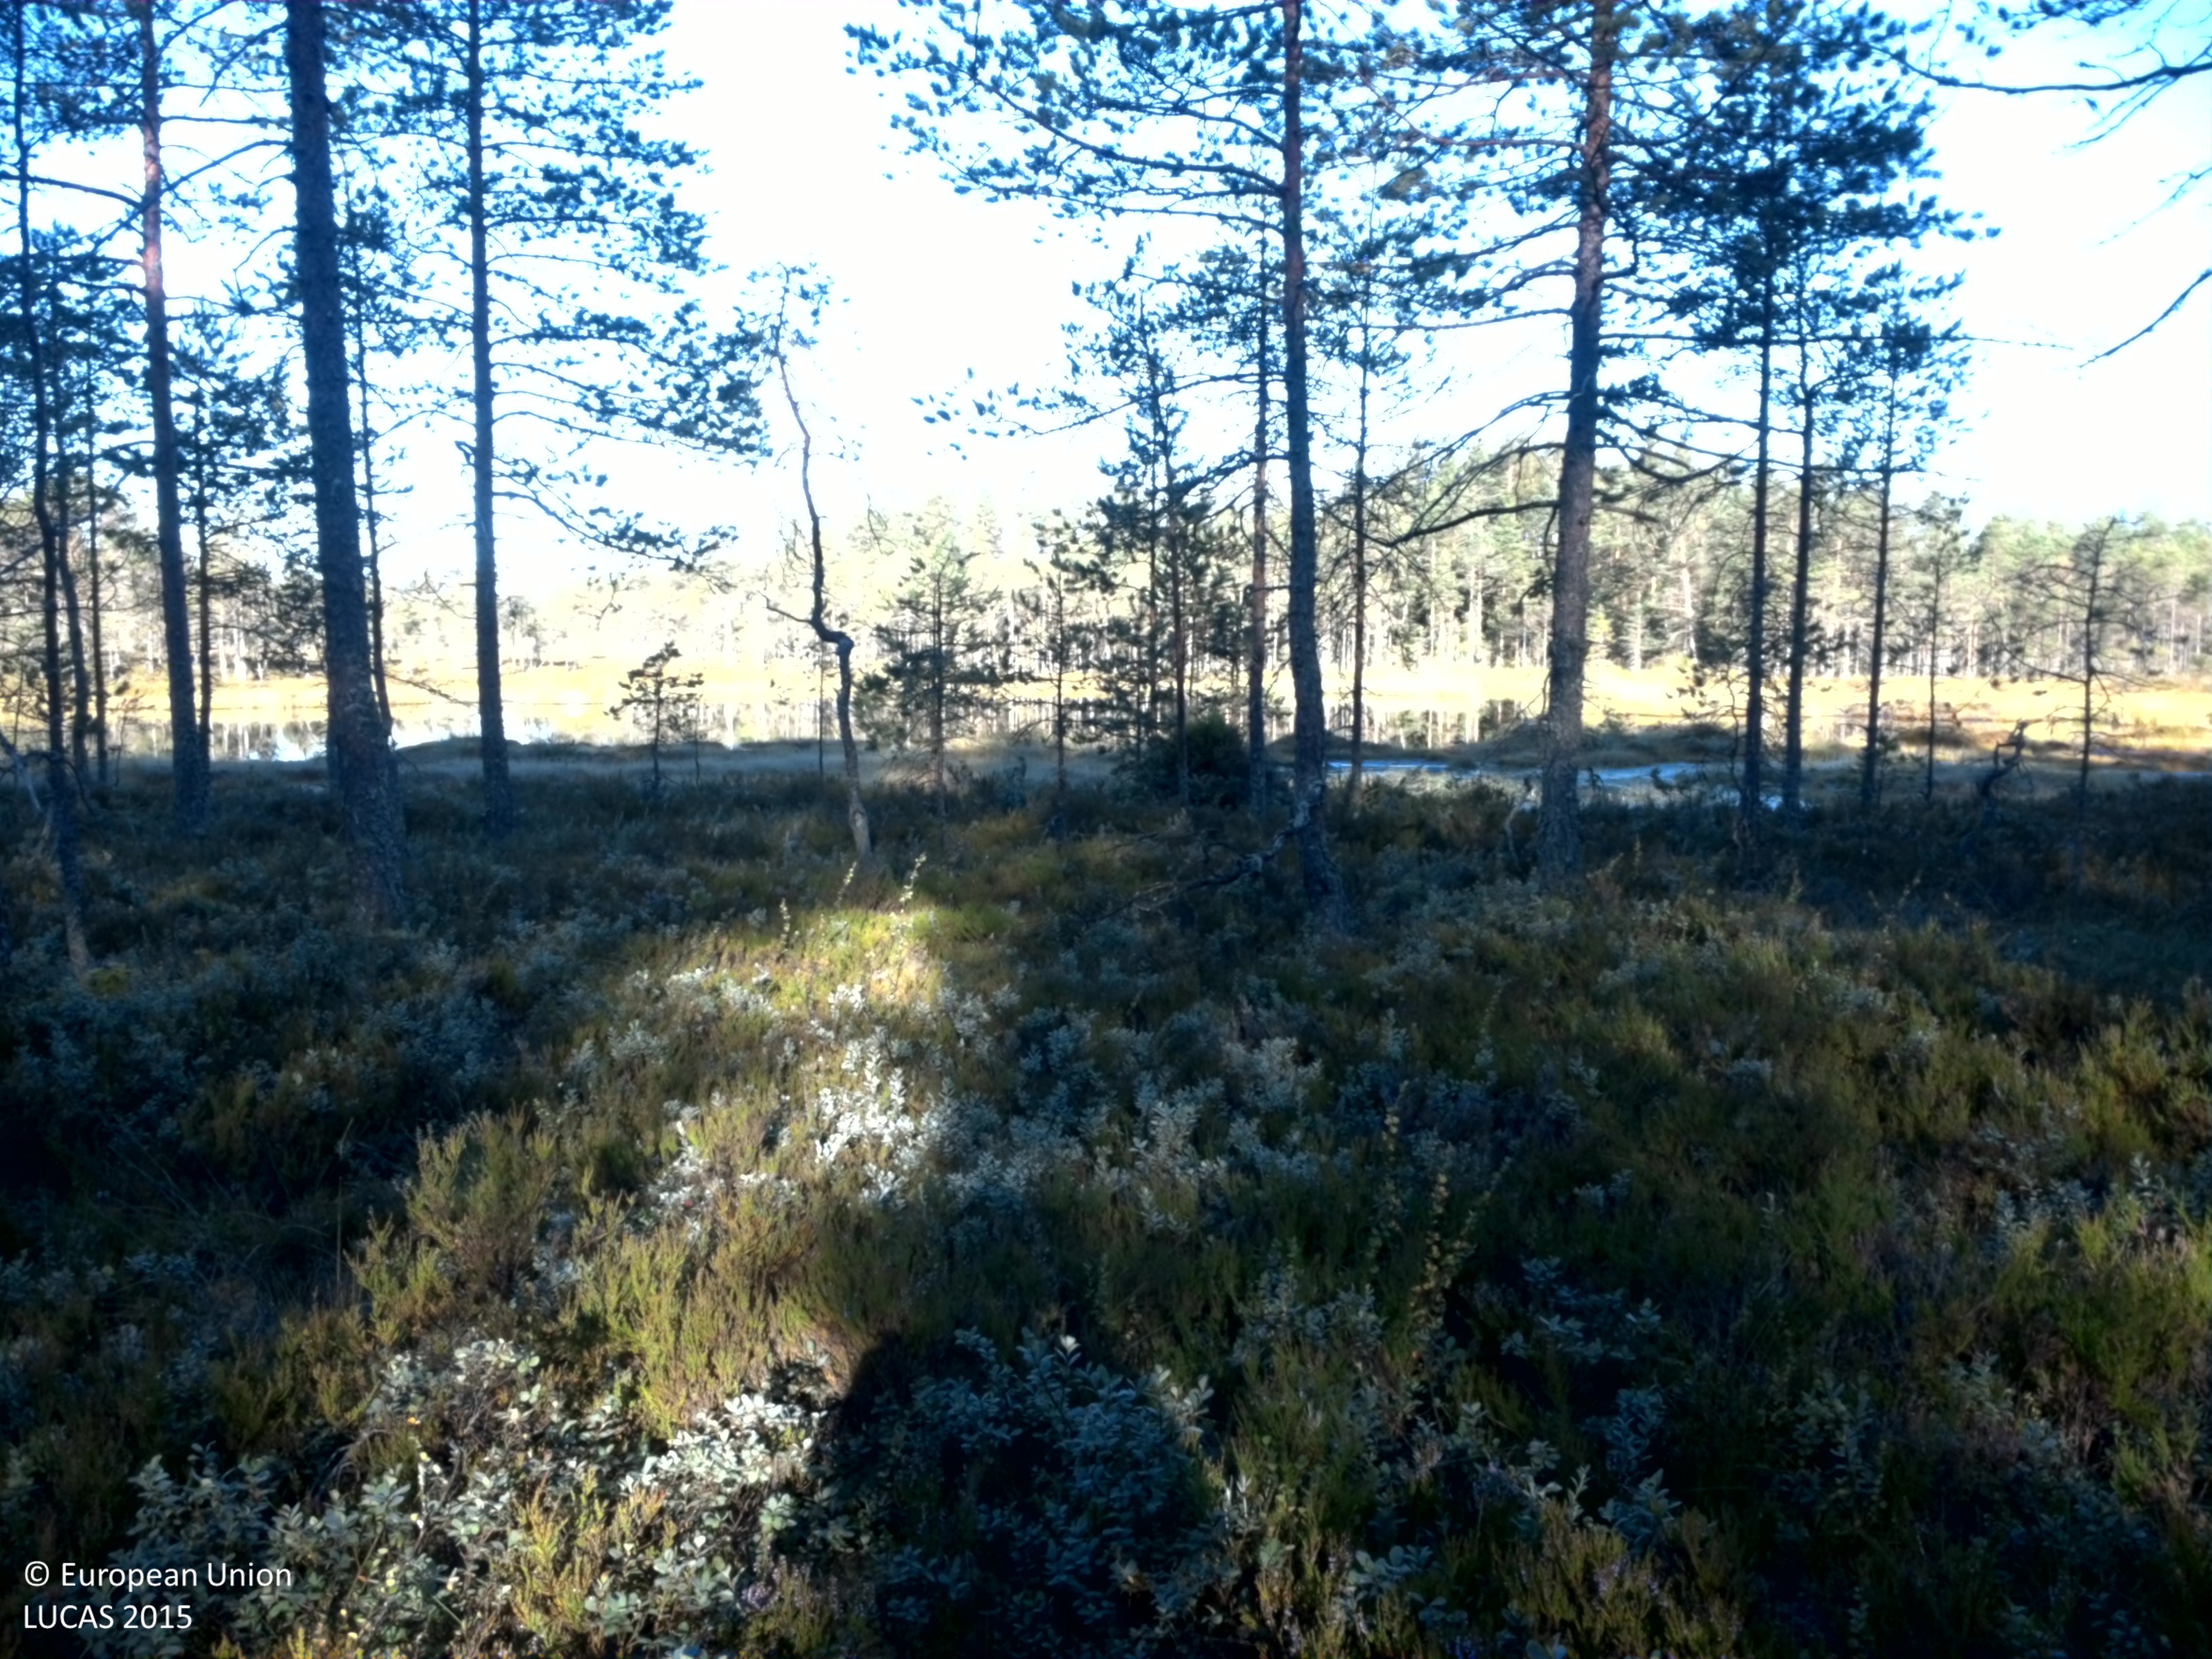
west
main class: Woodland
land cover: Pine dominated coniferous woodland
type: boreal forest
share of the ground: 25 - 50 %
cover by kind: coniferous forest trees 40 %, shrubs 40 %, lichens and mosses 20 %
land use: Semi-natural and natural areas not in use
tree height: > 5 m
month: August
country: SE
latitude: 59.9031
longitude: 14.1557
